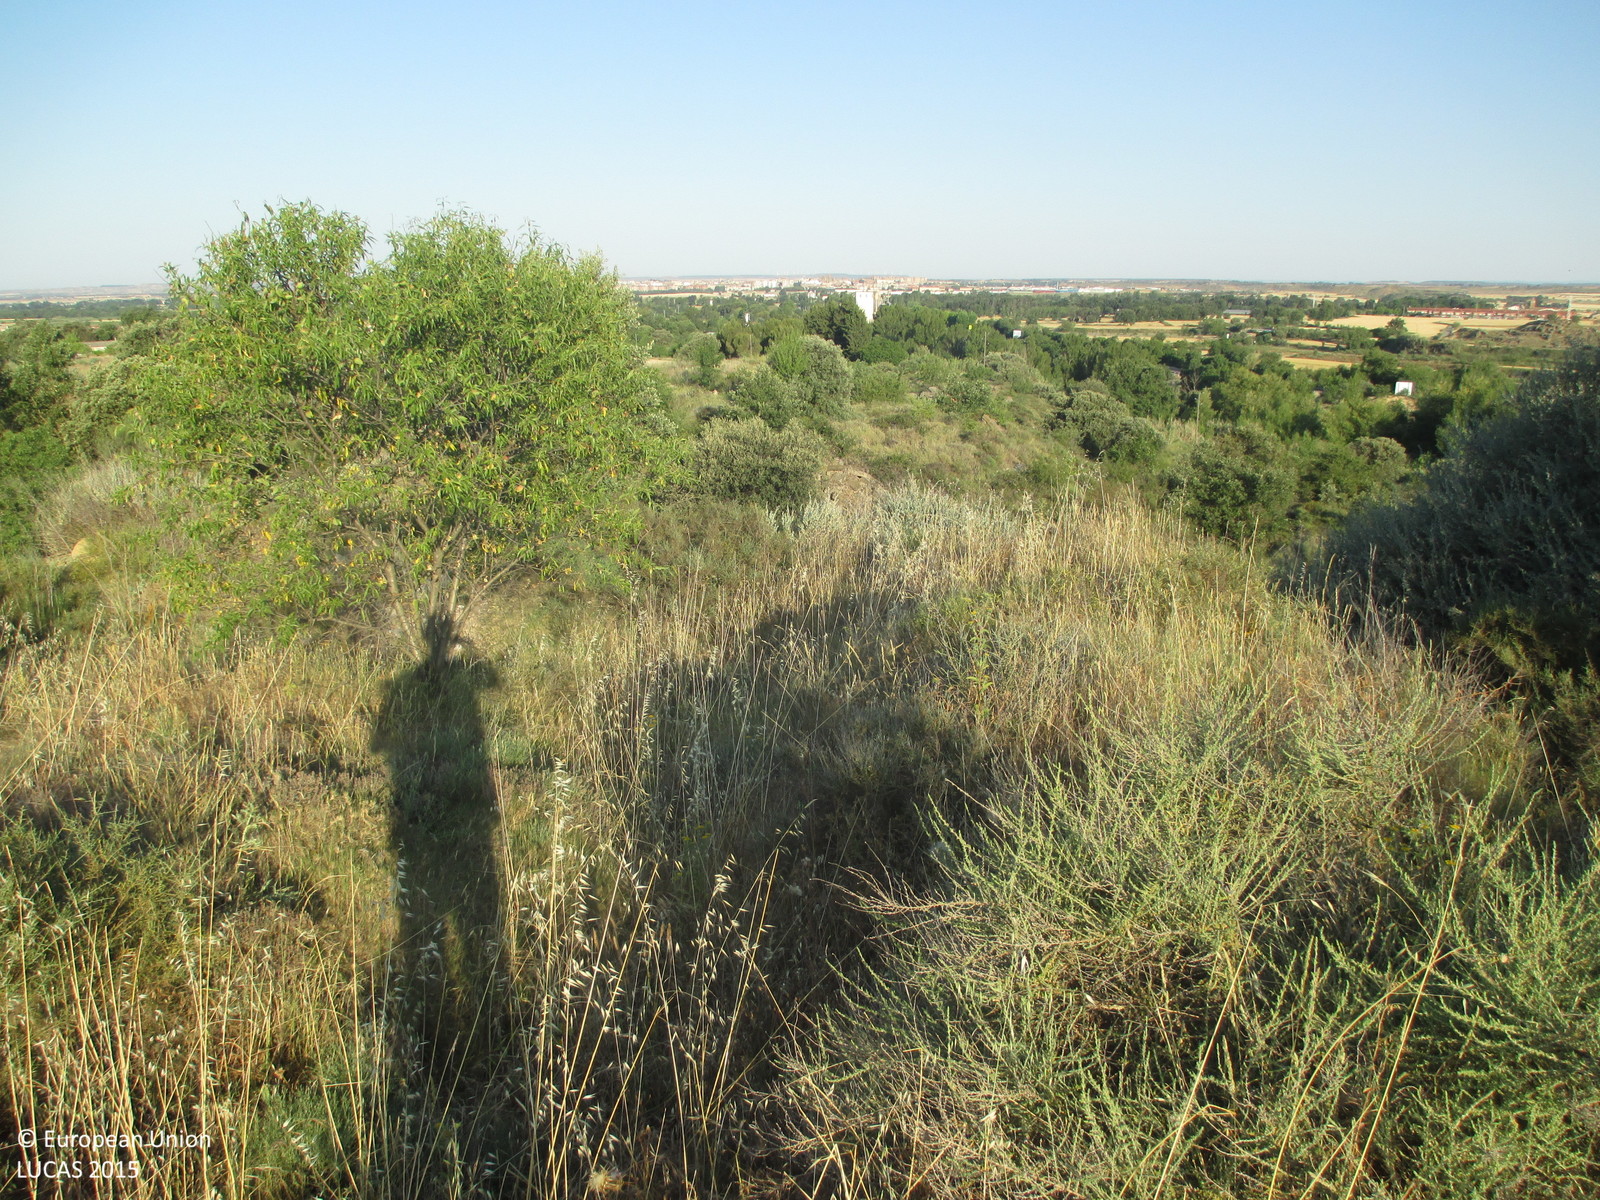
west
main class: Grassland
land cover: Grassland with sparse tree/shrub cover
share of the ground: > 75 %
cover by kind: herbaceous plants 90 %, broadleaved forest trees 5 %, shrubs 5 %
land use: Semi-natural and natural areas not in use
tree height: < 5 m
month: June
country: ES
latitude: 42.1413
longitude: -0.3431
